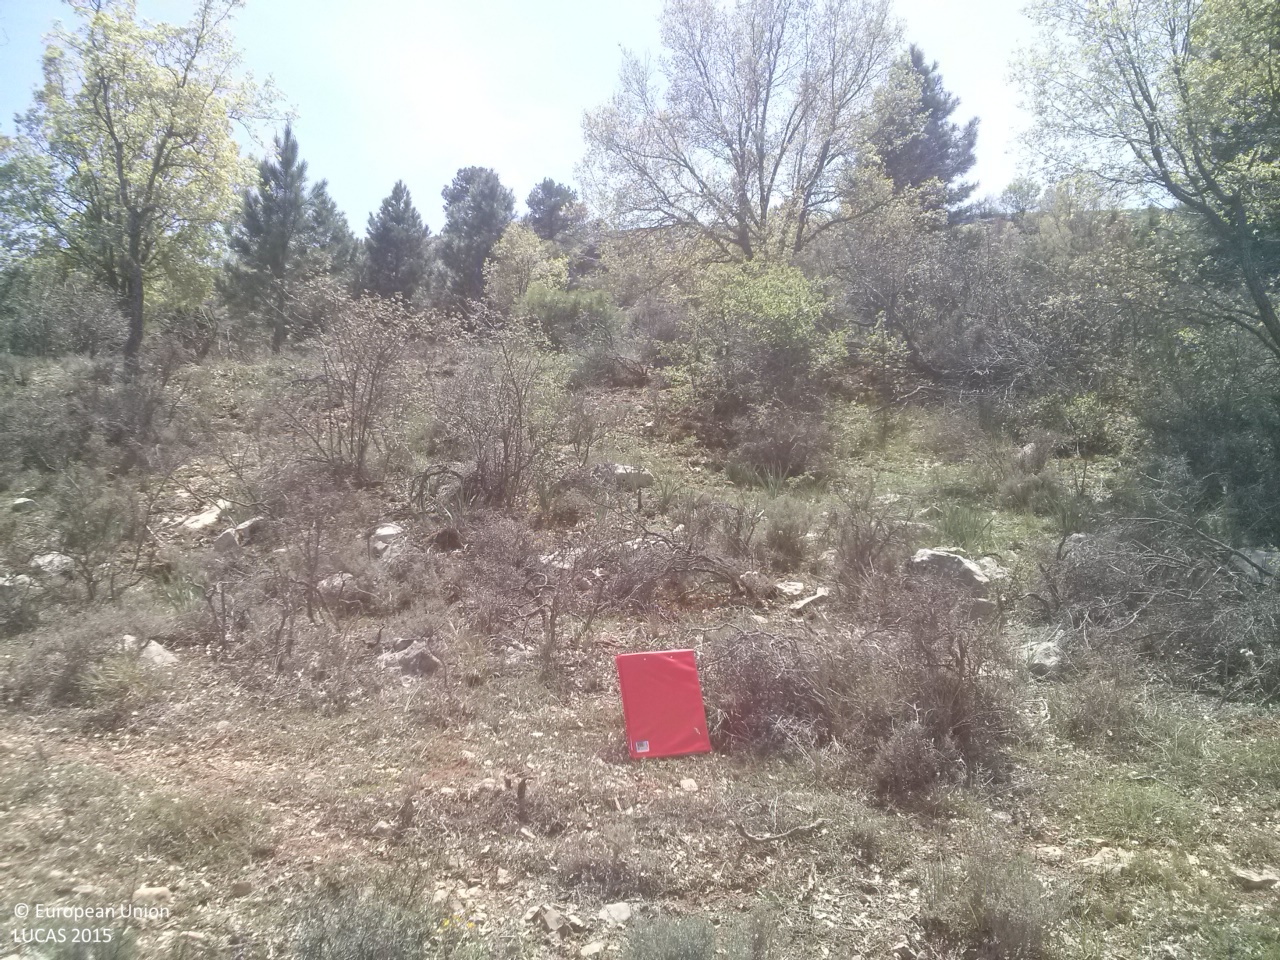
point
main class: Woodland
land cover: Other mixed woodland
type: thermophilous deciduous forest
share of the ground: 10 - 25 %
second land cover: Shrubland without tree cover
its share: 50 - 75 %
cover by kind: shrubs 40 %, herbaceous plants 35 %, broadleaved forest trees 15 %, coniferous forest trees 5 %, unconsolidated bare surface 5 %
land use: Forestry
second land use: Agriculture (excluding fallow land and kitchen gardens)
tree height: > 5 m
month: April
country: ES
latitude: 40.0125
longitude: -1.6208
